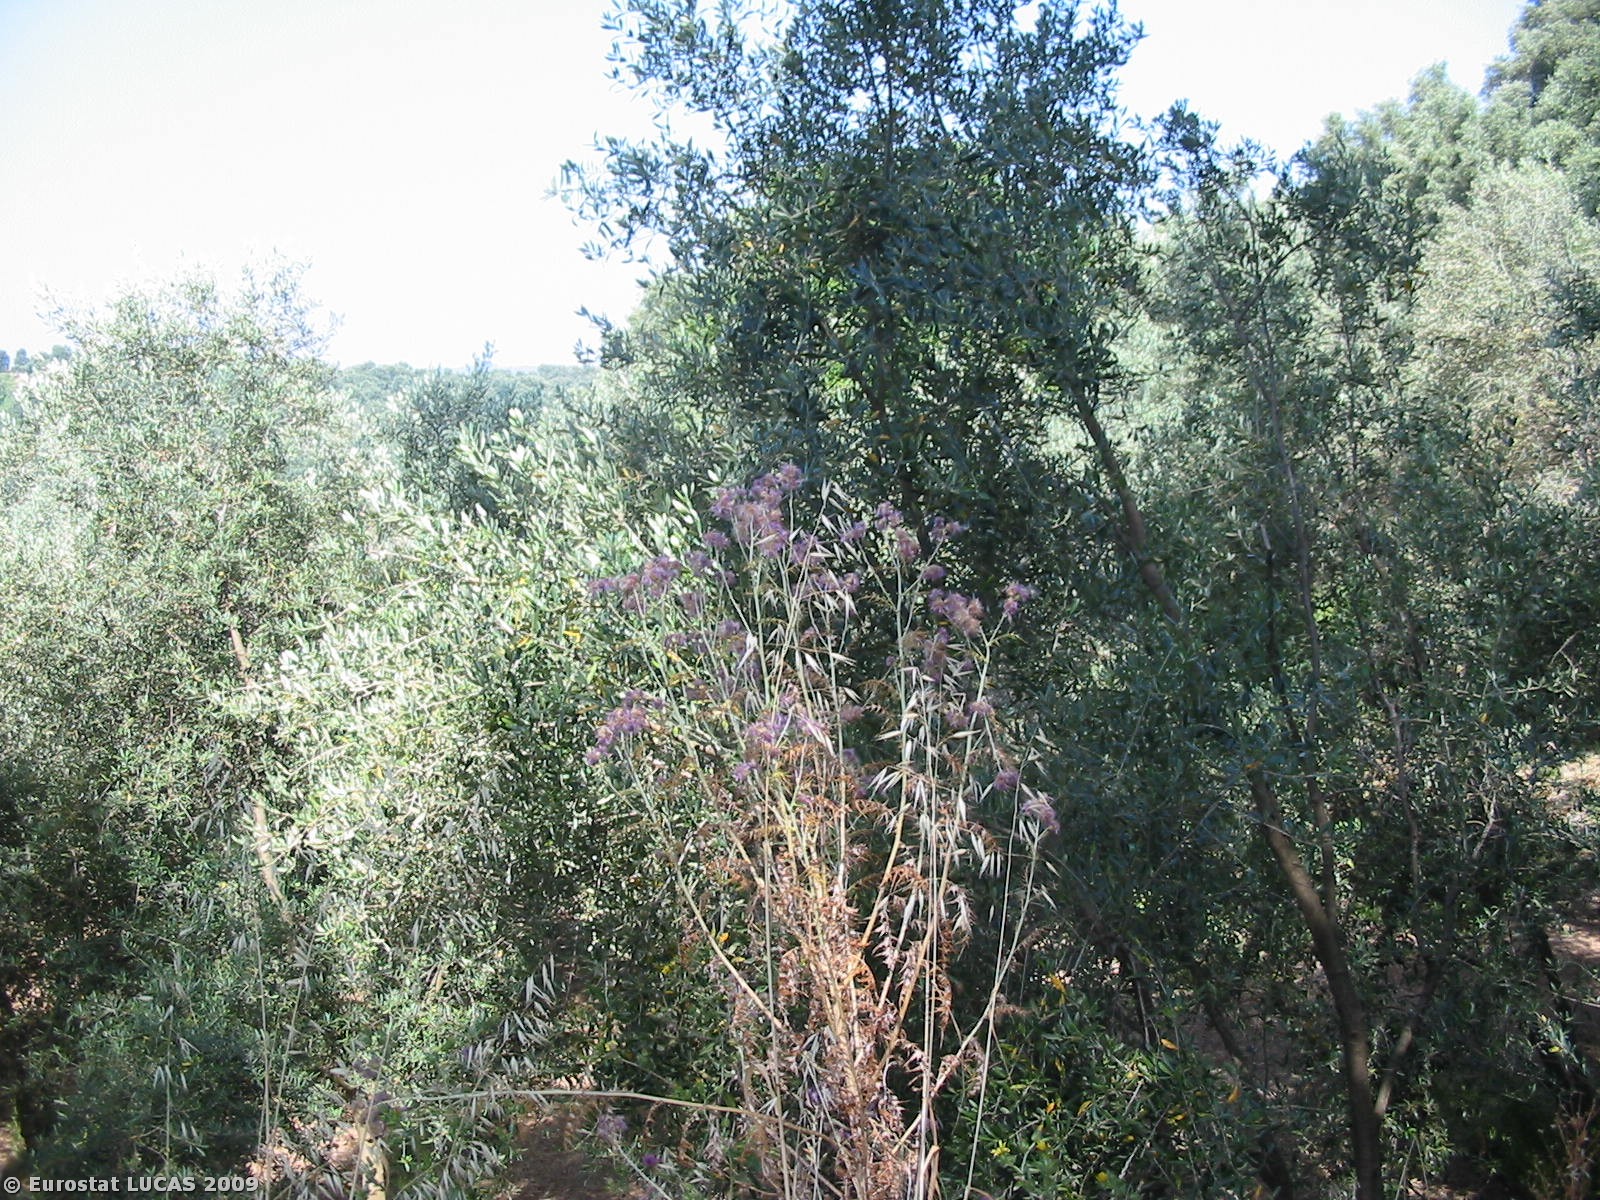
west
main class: Cropland
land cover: Olive groves
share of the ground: 50 - 75 %
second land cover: Bare land
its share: > 75 %
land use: Agriculture (excluding fallow land and kitchen gardens)
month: June
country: IT
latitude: 38.2890
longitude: 15.9436
